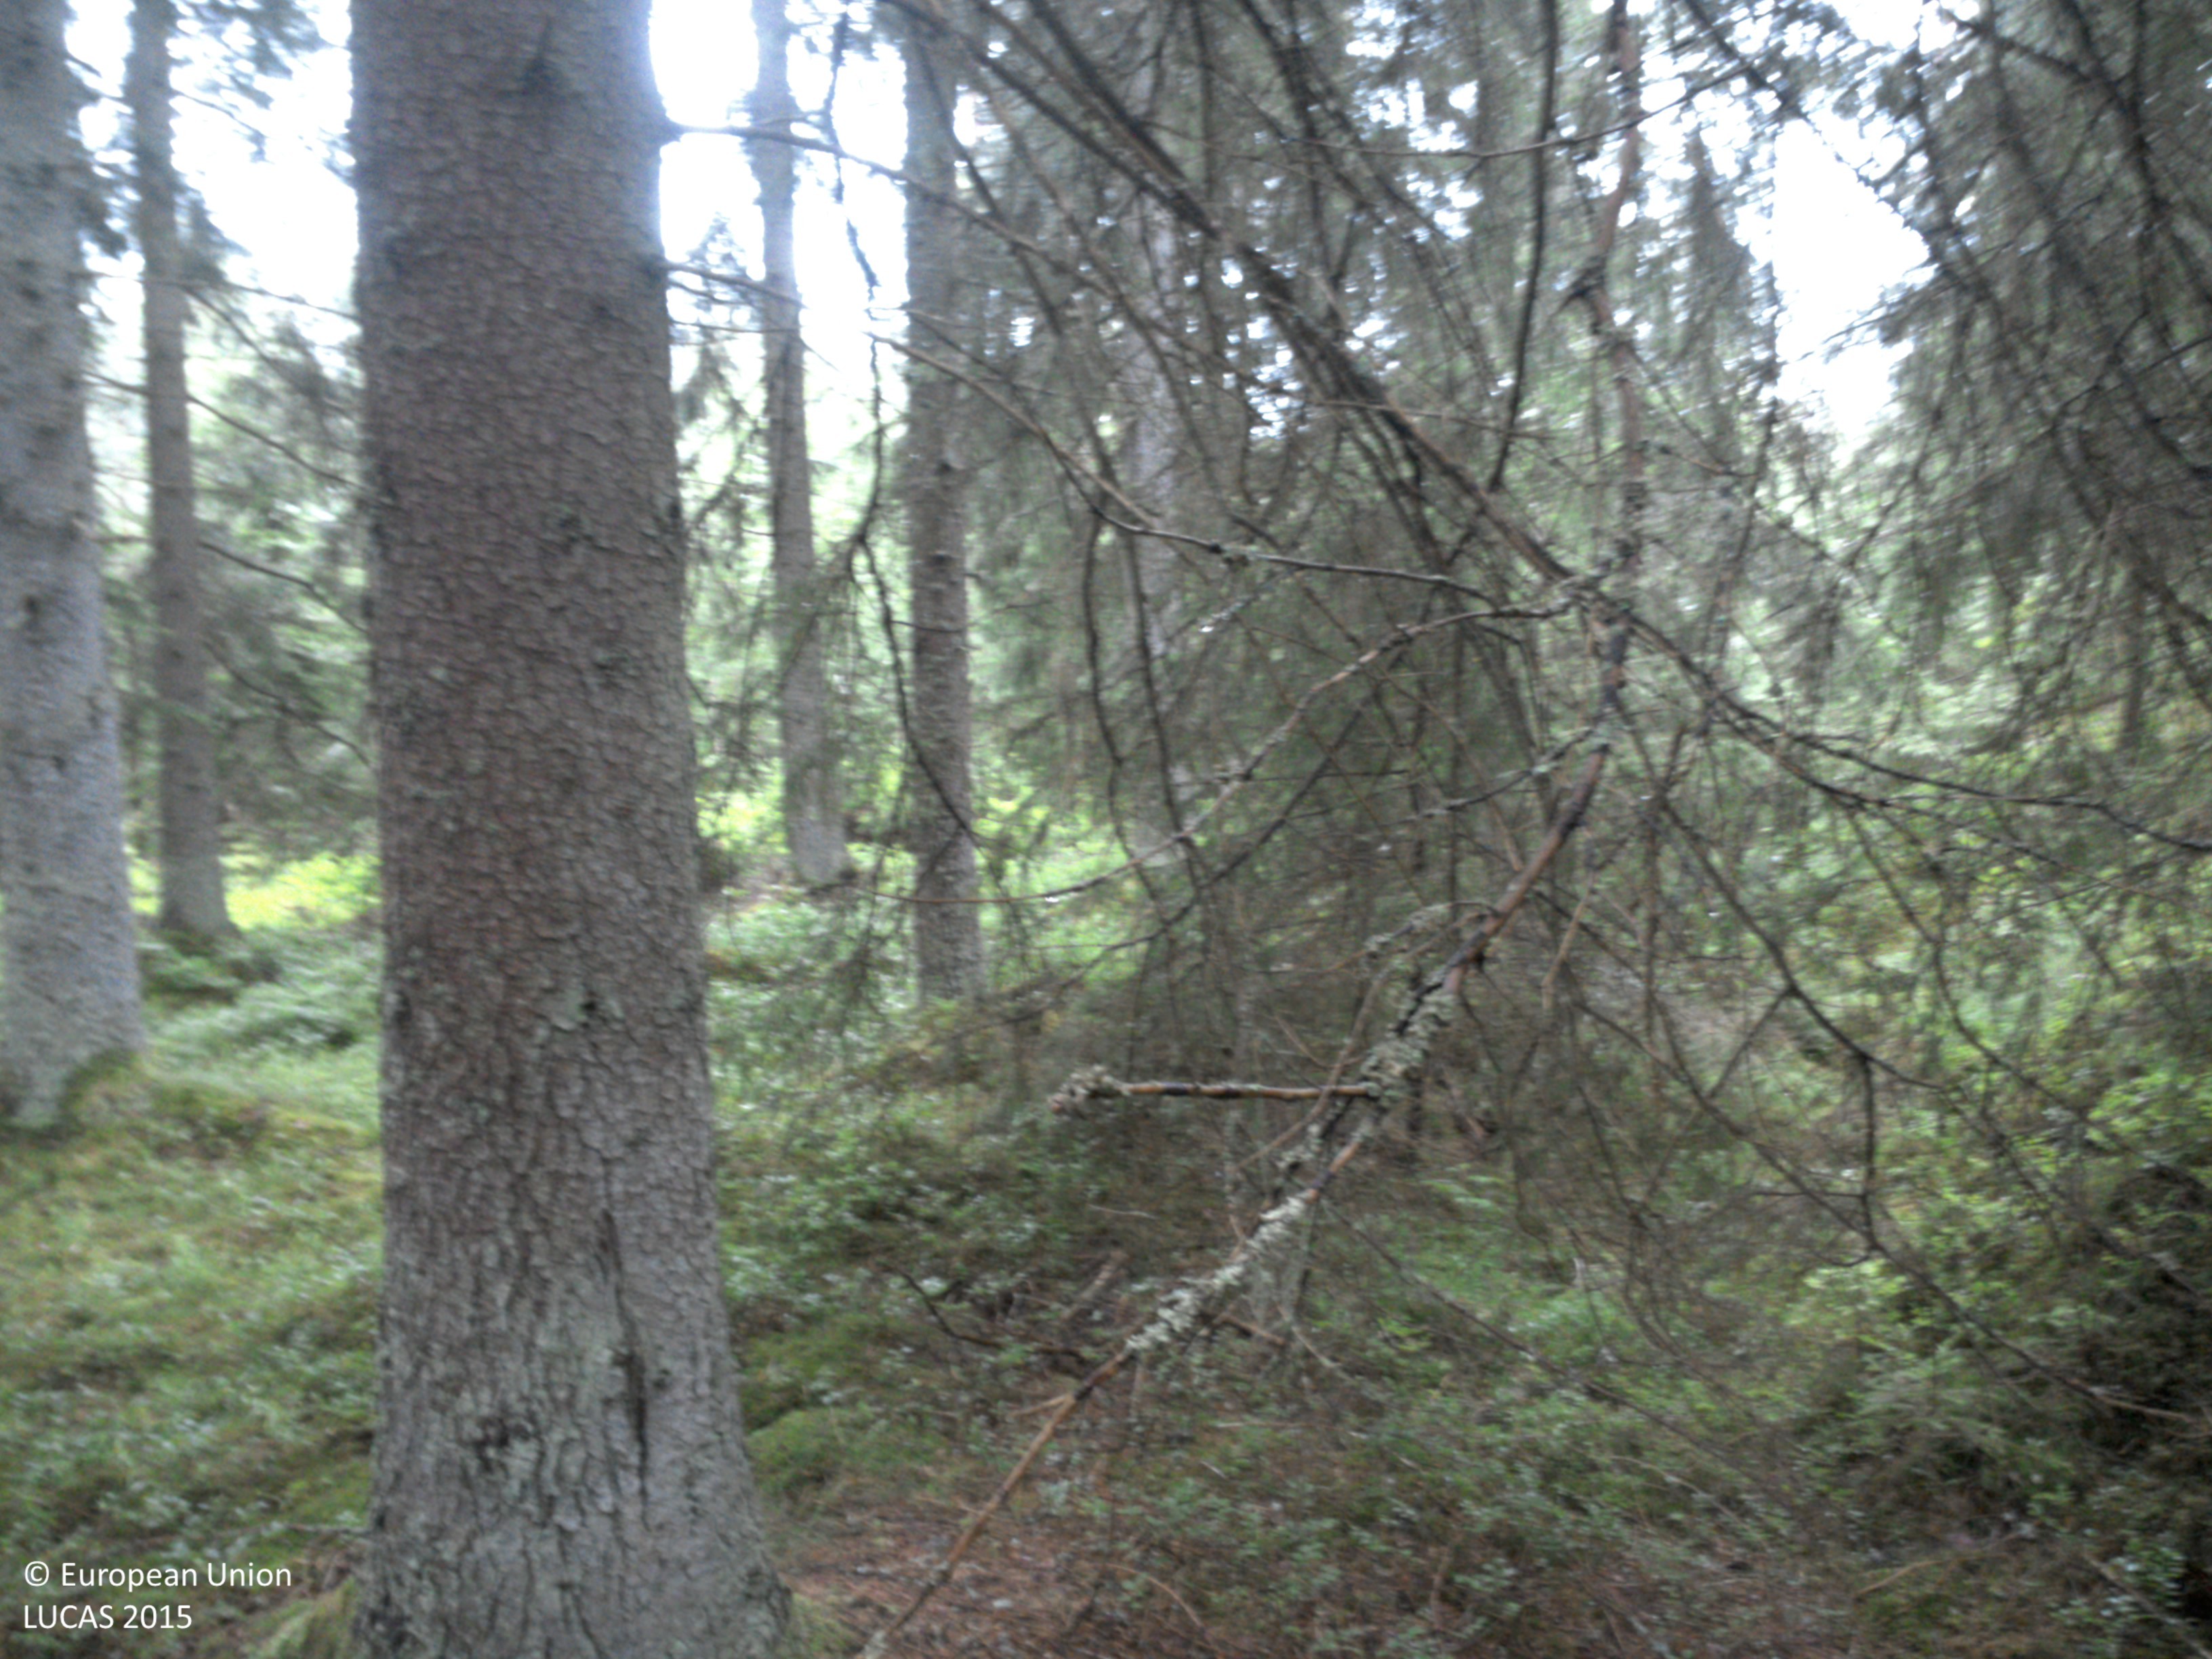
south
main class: Woodland
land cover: Spruce dominated coniferous woodland
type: boreal forest
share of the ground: 50 - 75 %
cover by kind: coniferous forest trees 65 %, lichens and mosses 20 %, herbaceous plants 15 %
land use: Forestry
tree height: > 5 m
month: July
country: SE
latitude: 58.6732
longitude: 11.9444
